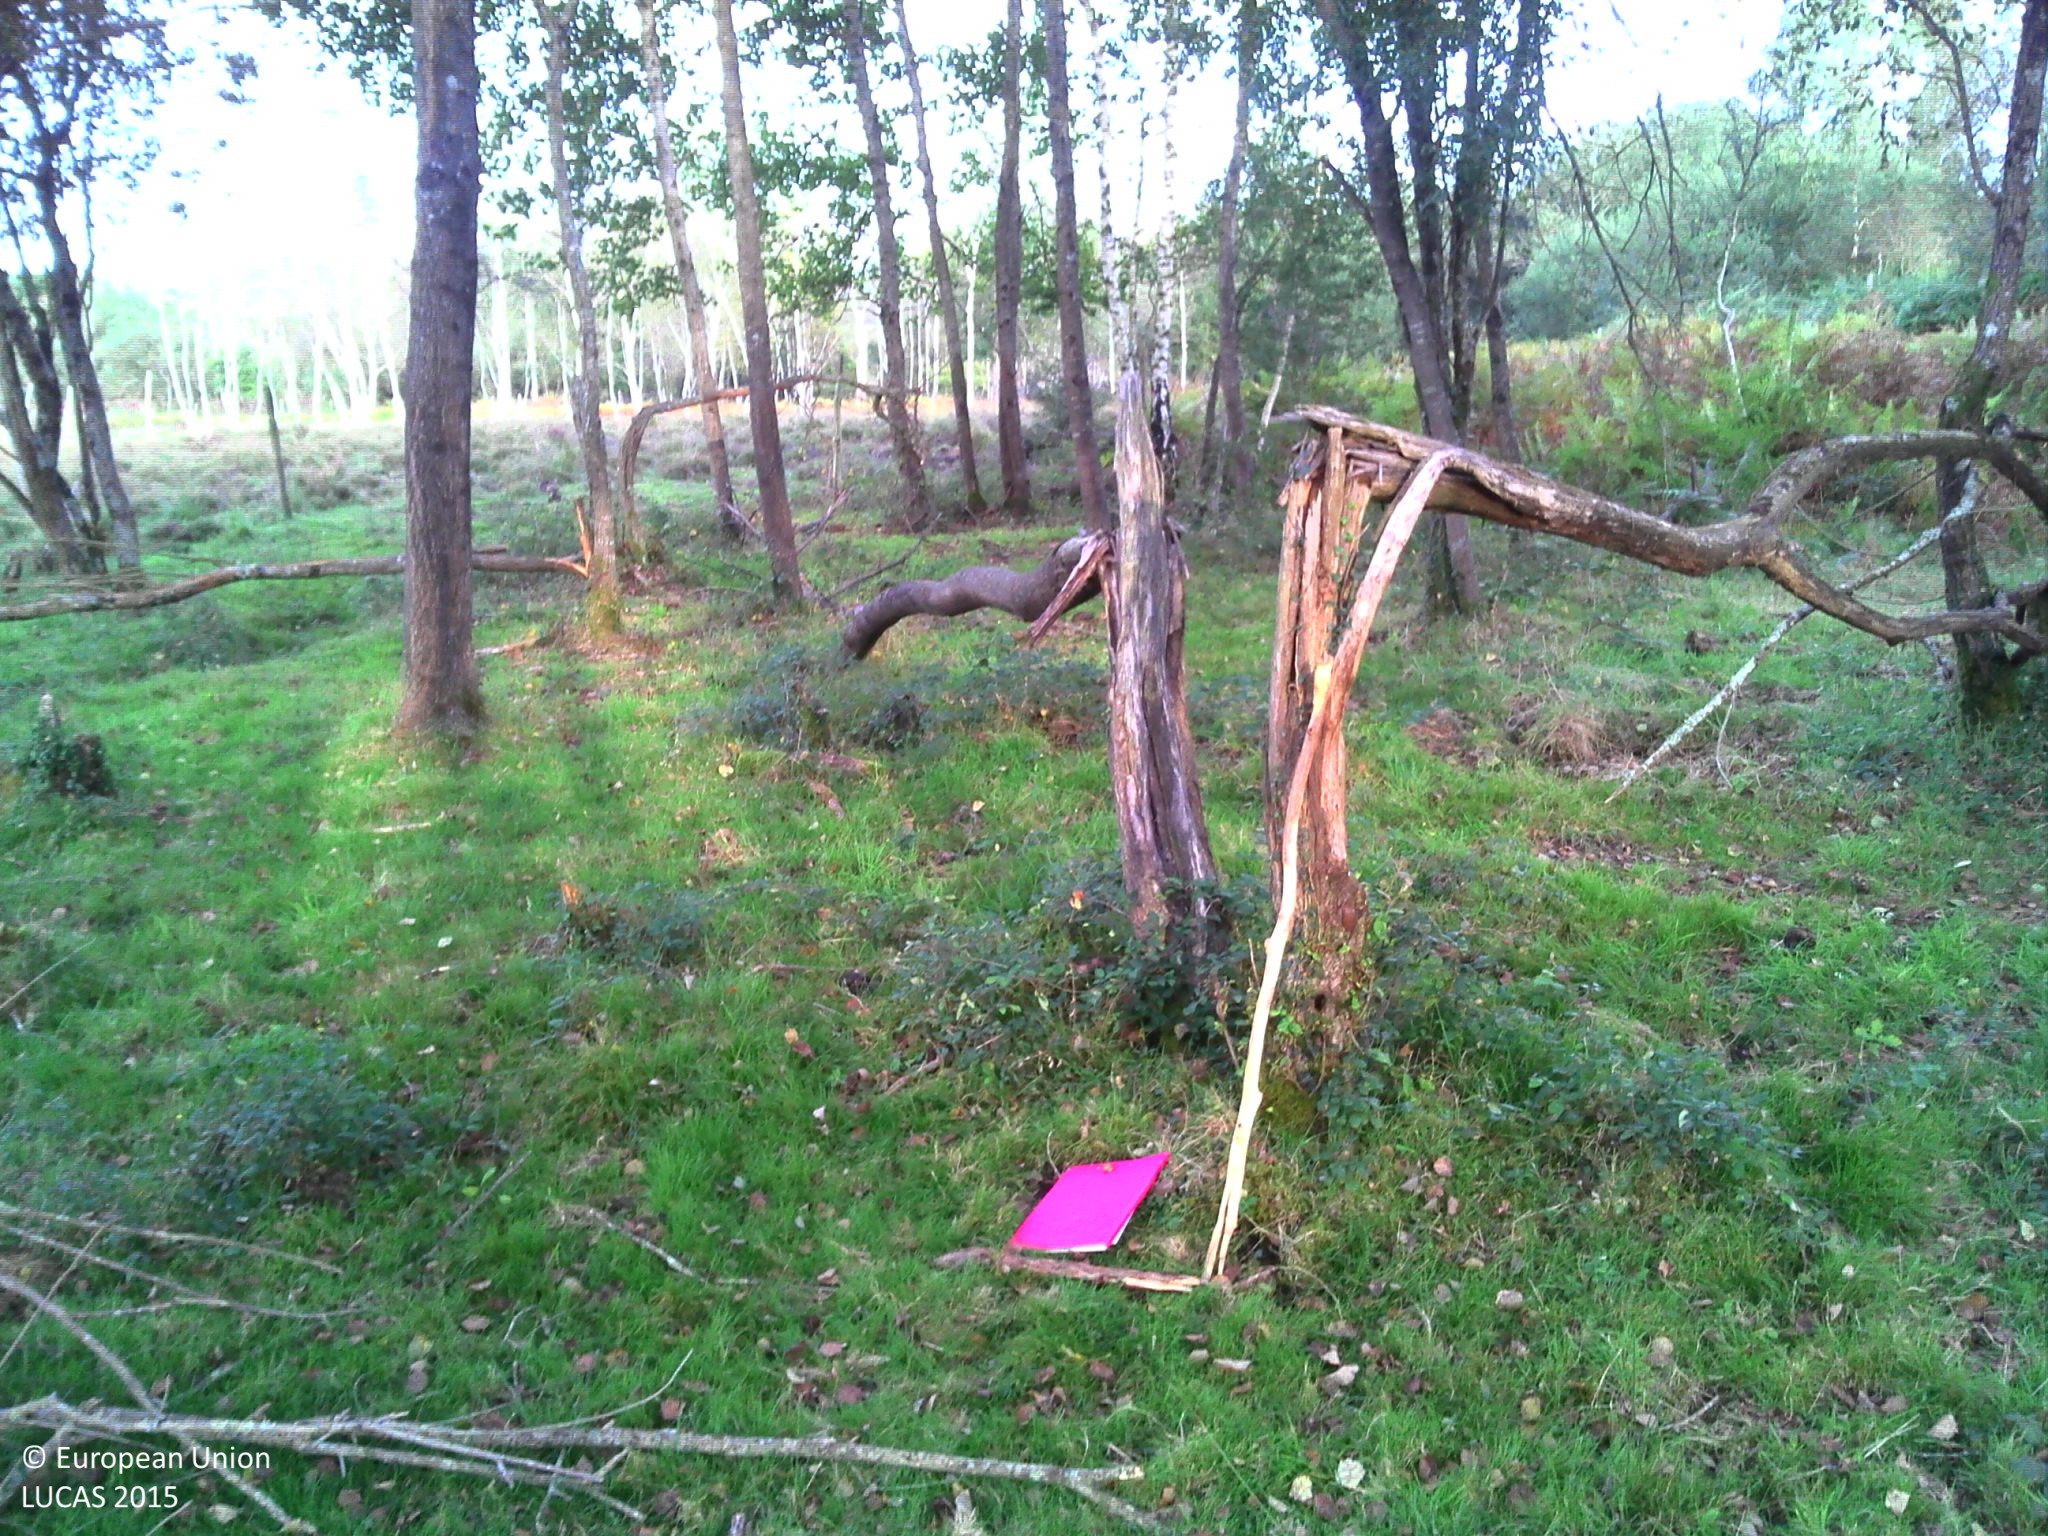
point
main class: Woodland
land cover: Broadleaved woodland
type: exotic forest
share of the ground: 50 - 75 %
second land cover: Grassland without tree/shrub cover
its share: > 75 %
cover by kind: broadleaved forest trees 55 %, herbaceous plants 40 %, lichens and mosses 5 %
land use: Forestry
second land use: Agriculture (excluding fallow land and kitchen gardens)
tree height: > 5 m
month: September
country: FR
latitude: 43.1493
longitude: -0.4461
